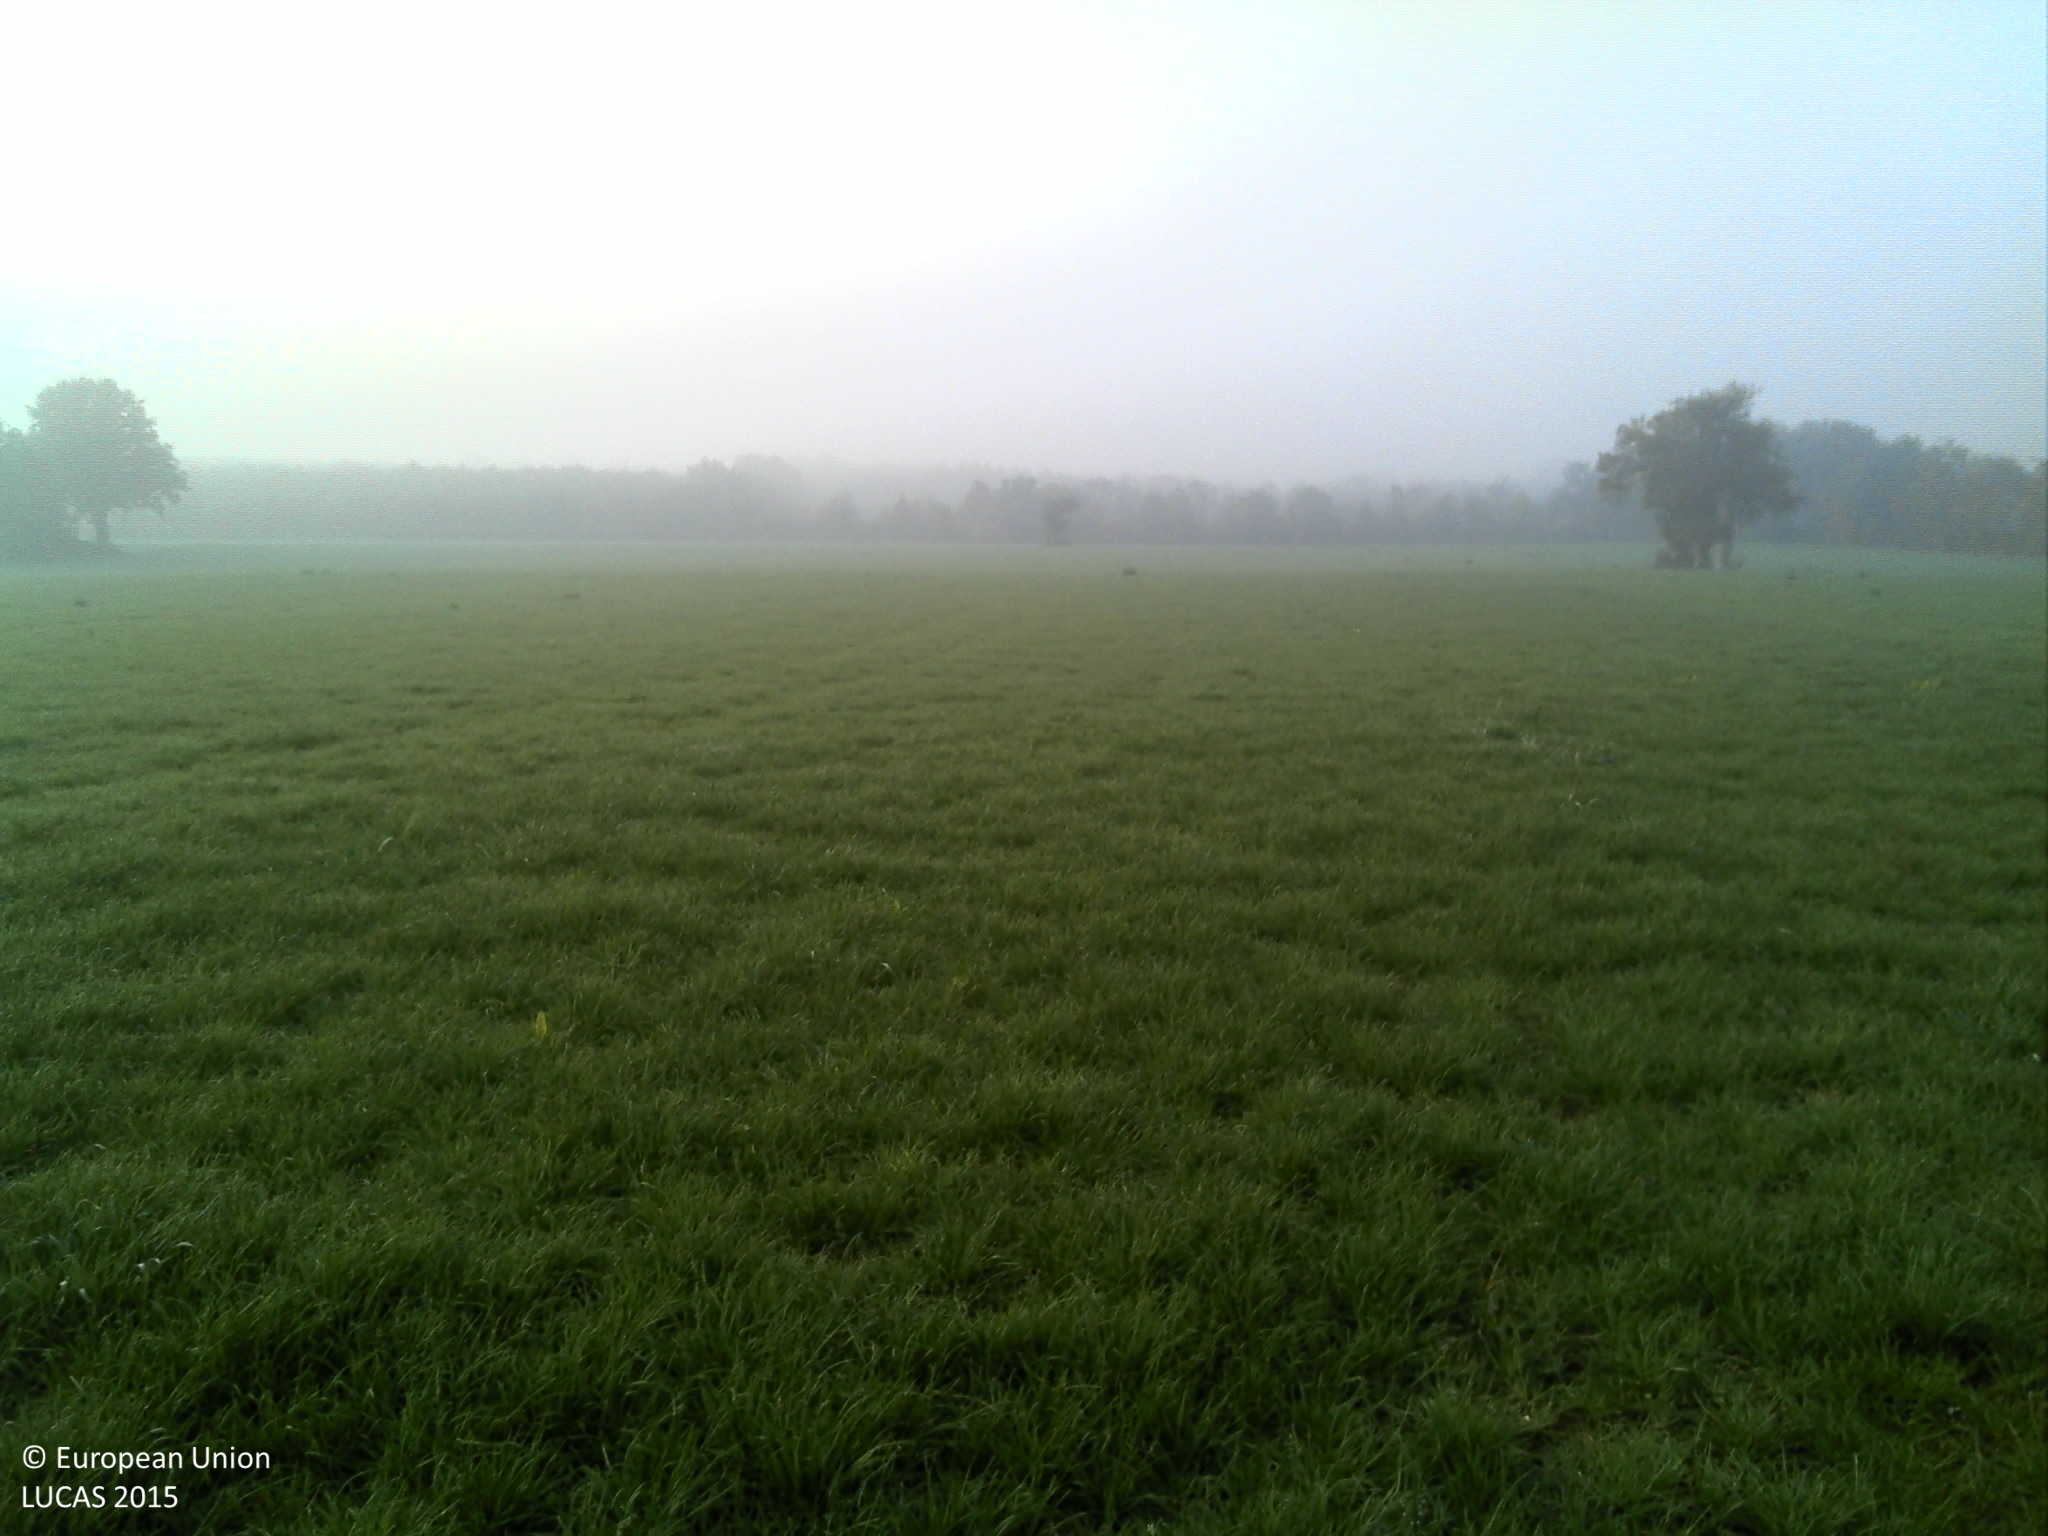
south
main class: Grassland
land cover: Grassland without tree/shrub cover
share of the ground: > 75 %
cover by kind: herbaceous plants 100 %
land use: Agriculture (excluding fallow land and kitchen gardens)
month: November
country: FR
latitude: 47.4038
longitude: -1.4777
